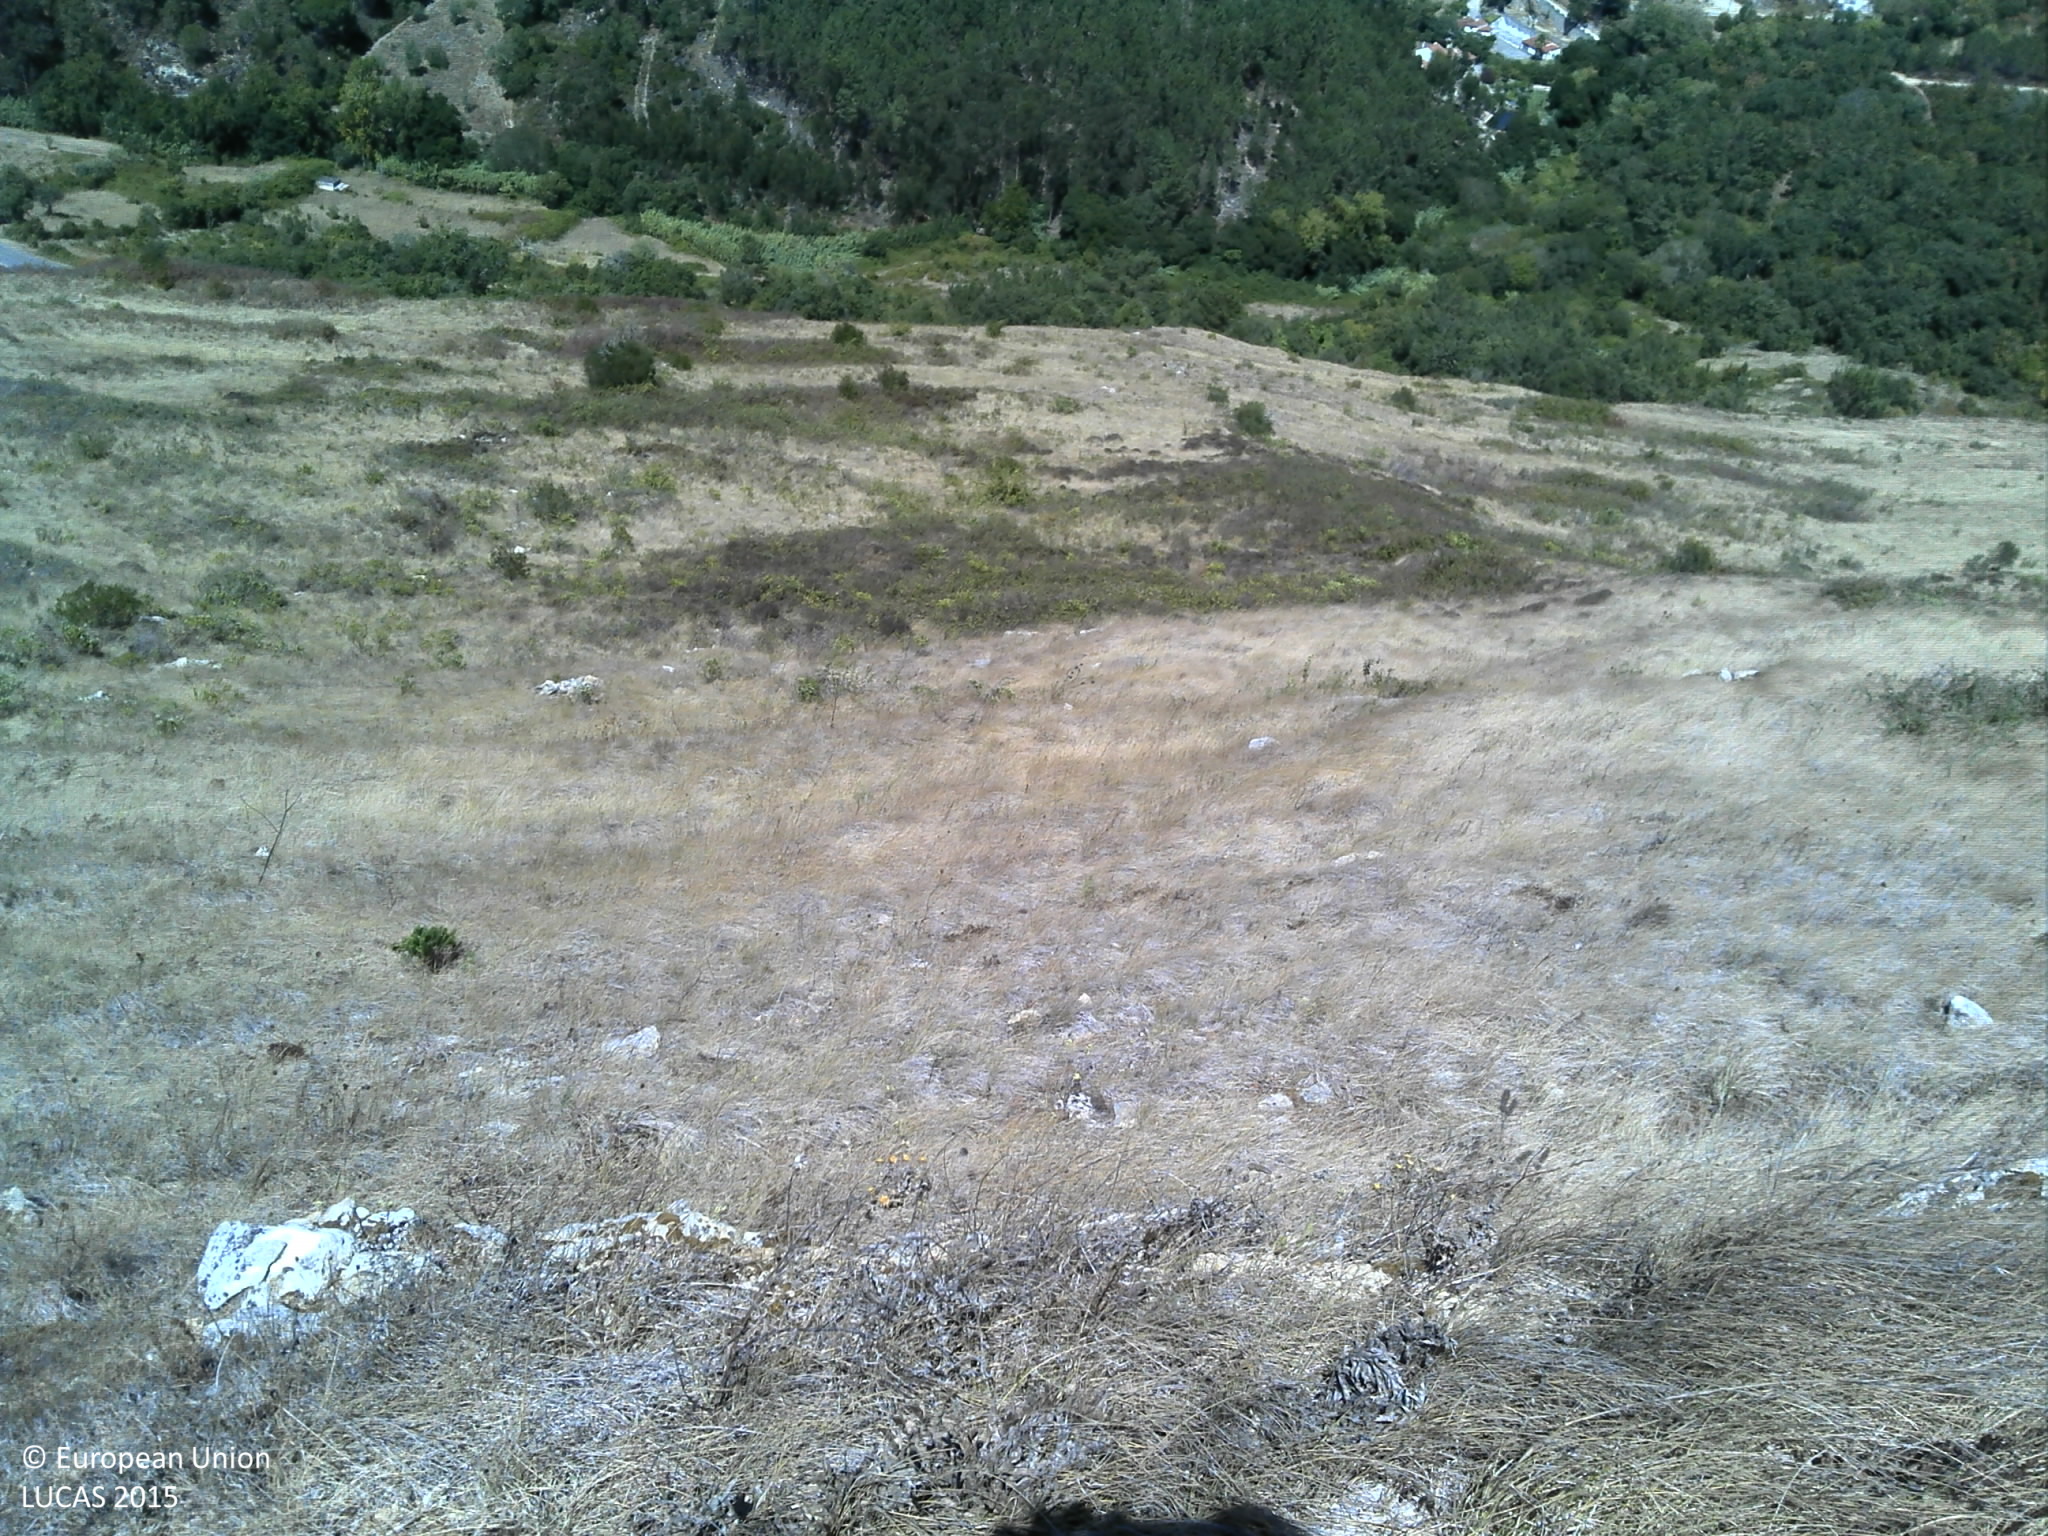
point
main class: Grassland
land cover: Grassland without tree/shrub cover
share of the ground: 50 - 75 %
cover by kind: herbaceous plants 70 %, unconsolidated bare surface 30 %
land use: Semi-natural and natural areas not in use
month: August
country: PT
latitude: 38.8961
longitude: -9.1613
